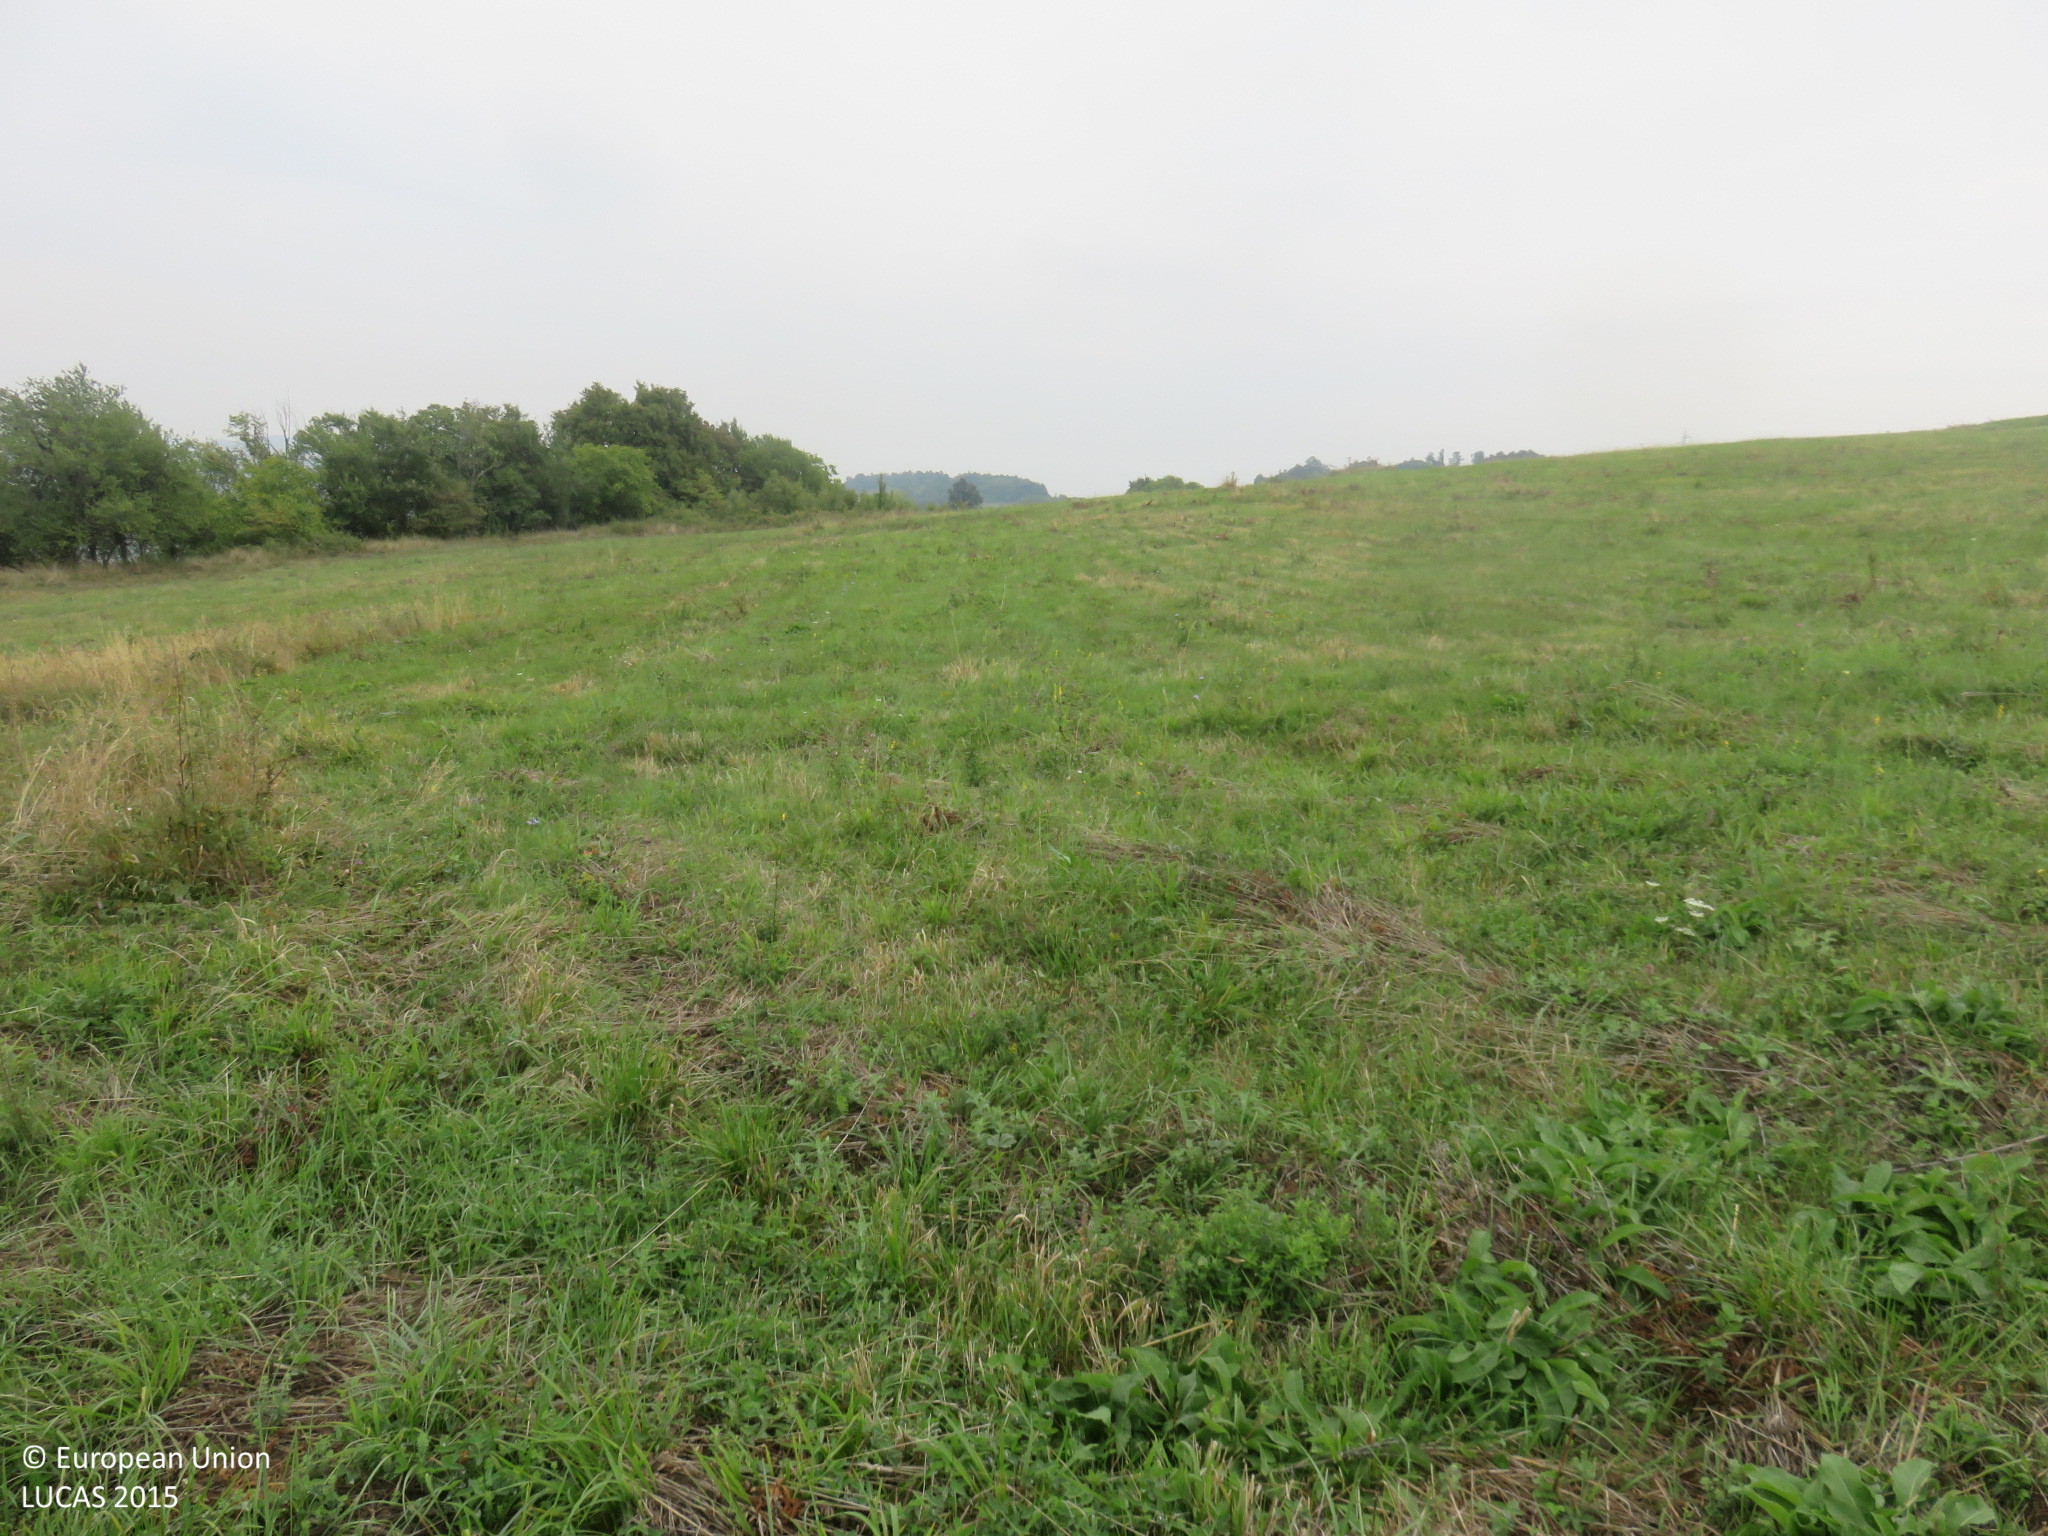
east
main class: Grassland
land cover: Grassland without tree/shrub cover
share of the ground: > 75 %
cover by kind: herbaceous plants 100 %
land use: Agriculture (excluding fallow land and kitchen gardens)
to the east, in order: Grassland without tree/shrub cover; Groves; Grassland without tree/shrub cover; Grassland with sparse tree/shrub cover
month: September
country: BG
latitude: 43.1141
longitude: 24.8234
